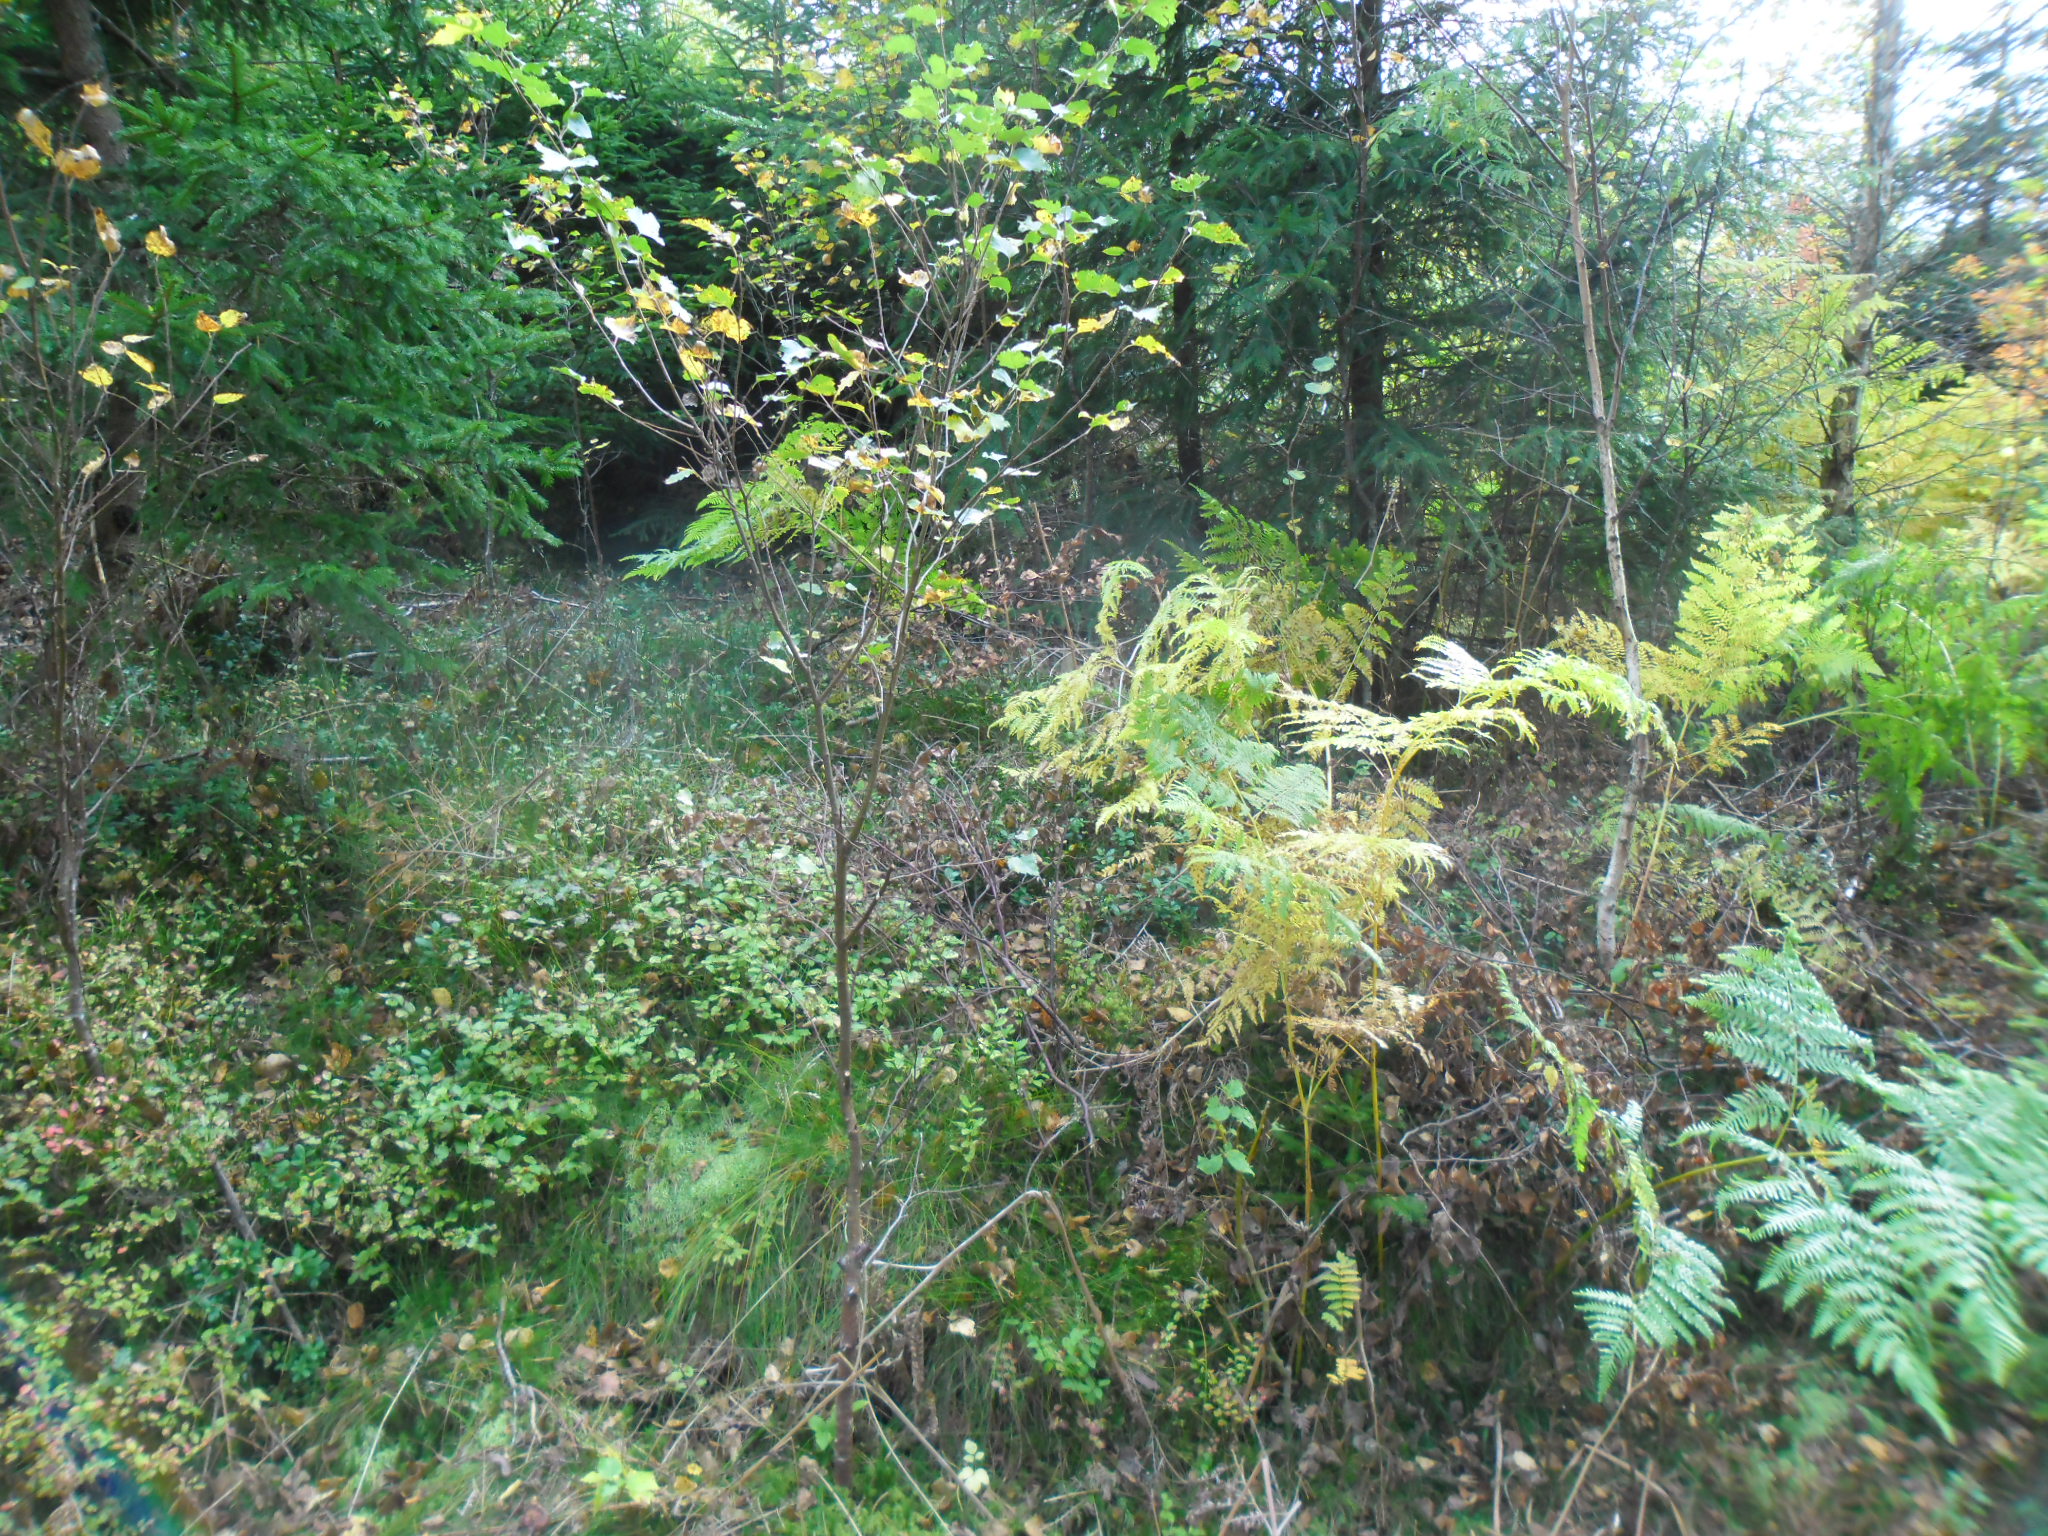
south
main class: Woodland
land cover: Spruce dominated coniferous woodland
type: boreal forest
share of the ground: > 75 %
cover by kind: coniferous forest trees 70 %, herbaceous plants 15 %, lichens and mosses 15 %
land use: Forestry
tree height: > 5 m
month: October
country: SE
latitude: 56.4193
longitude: 13.8067
